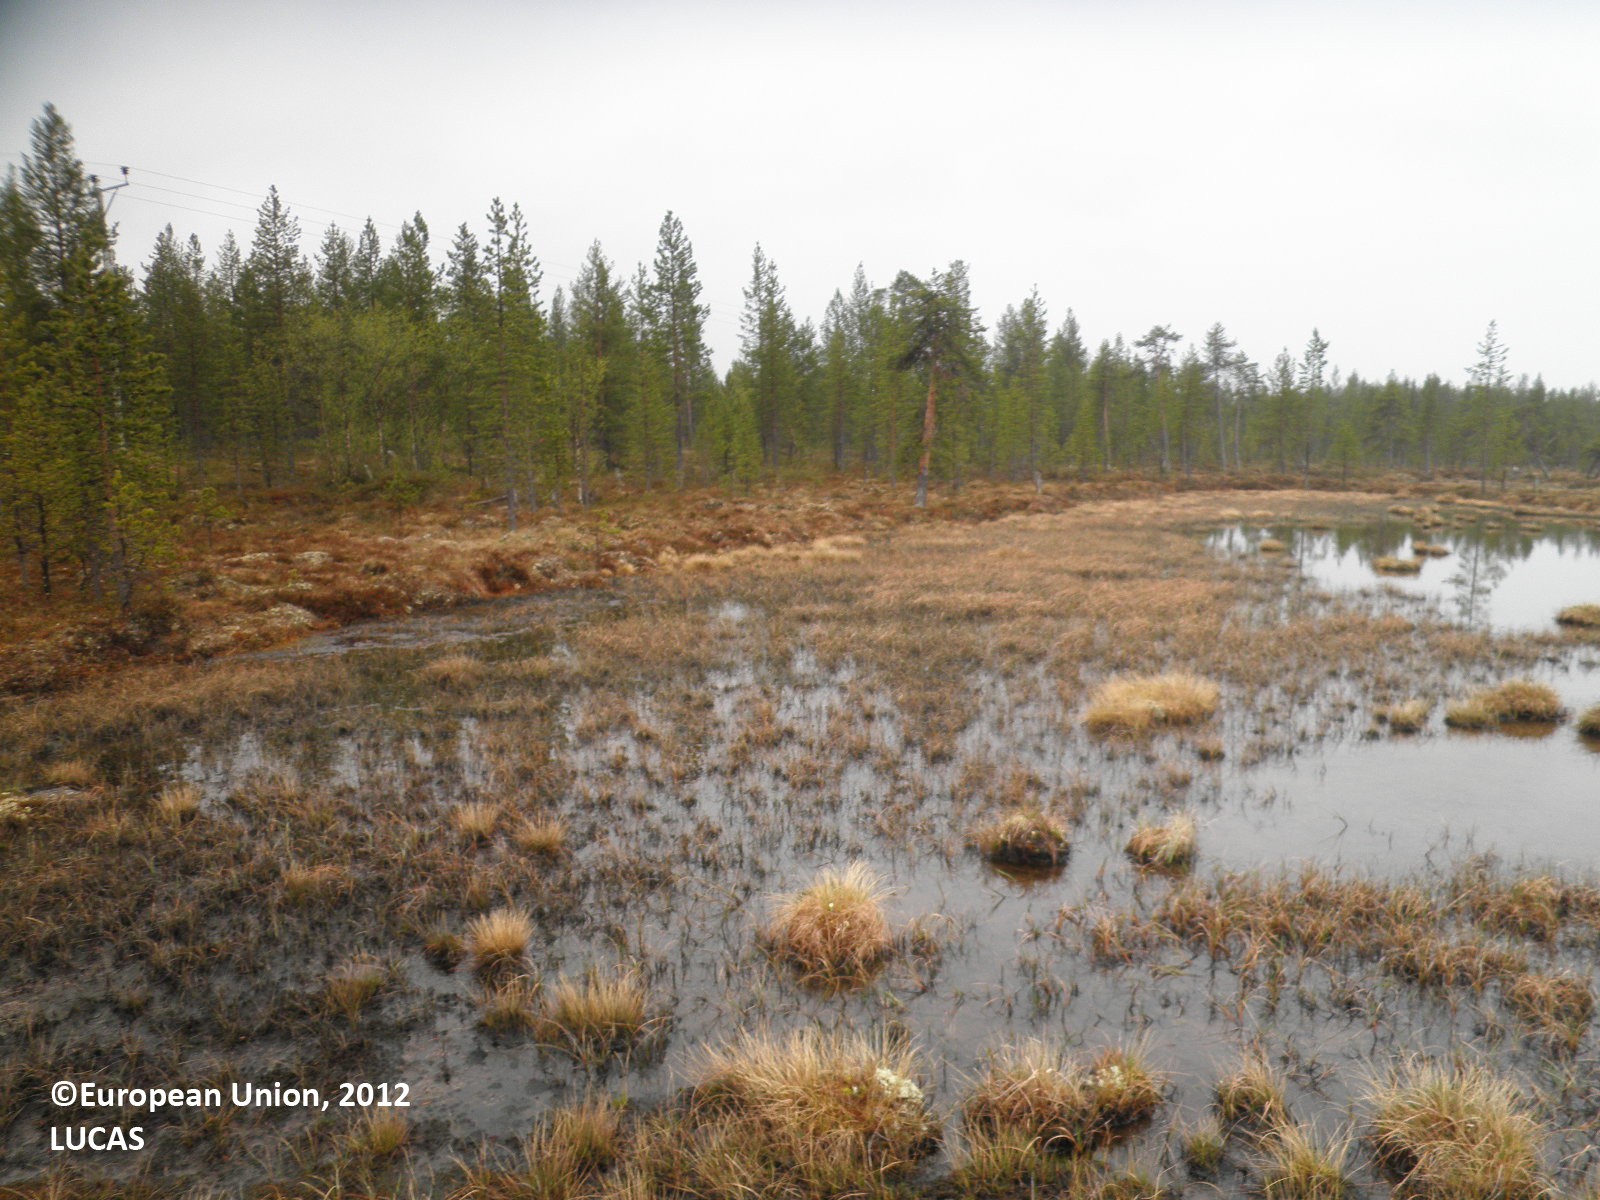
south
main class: Woodland
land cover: Pine dominated coniferous woodland
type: boreal forest
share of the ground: 10 - 25 %
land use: Forestry
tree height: > 5 m
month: June
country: FI
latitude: 69.1158
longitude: 27.2292
